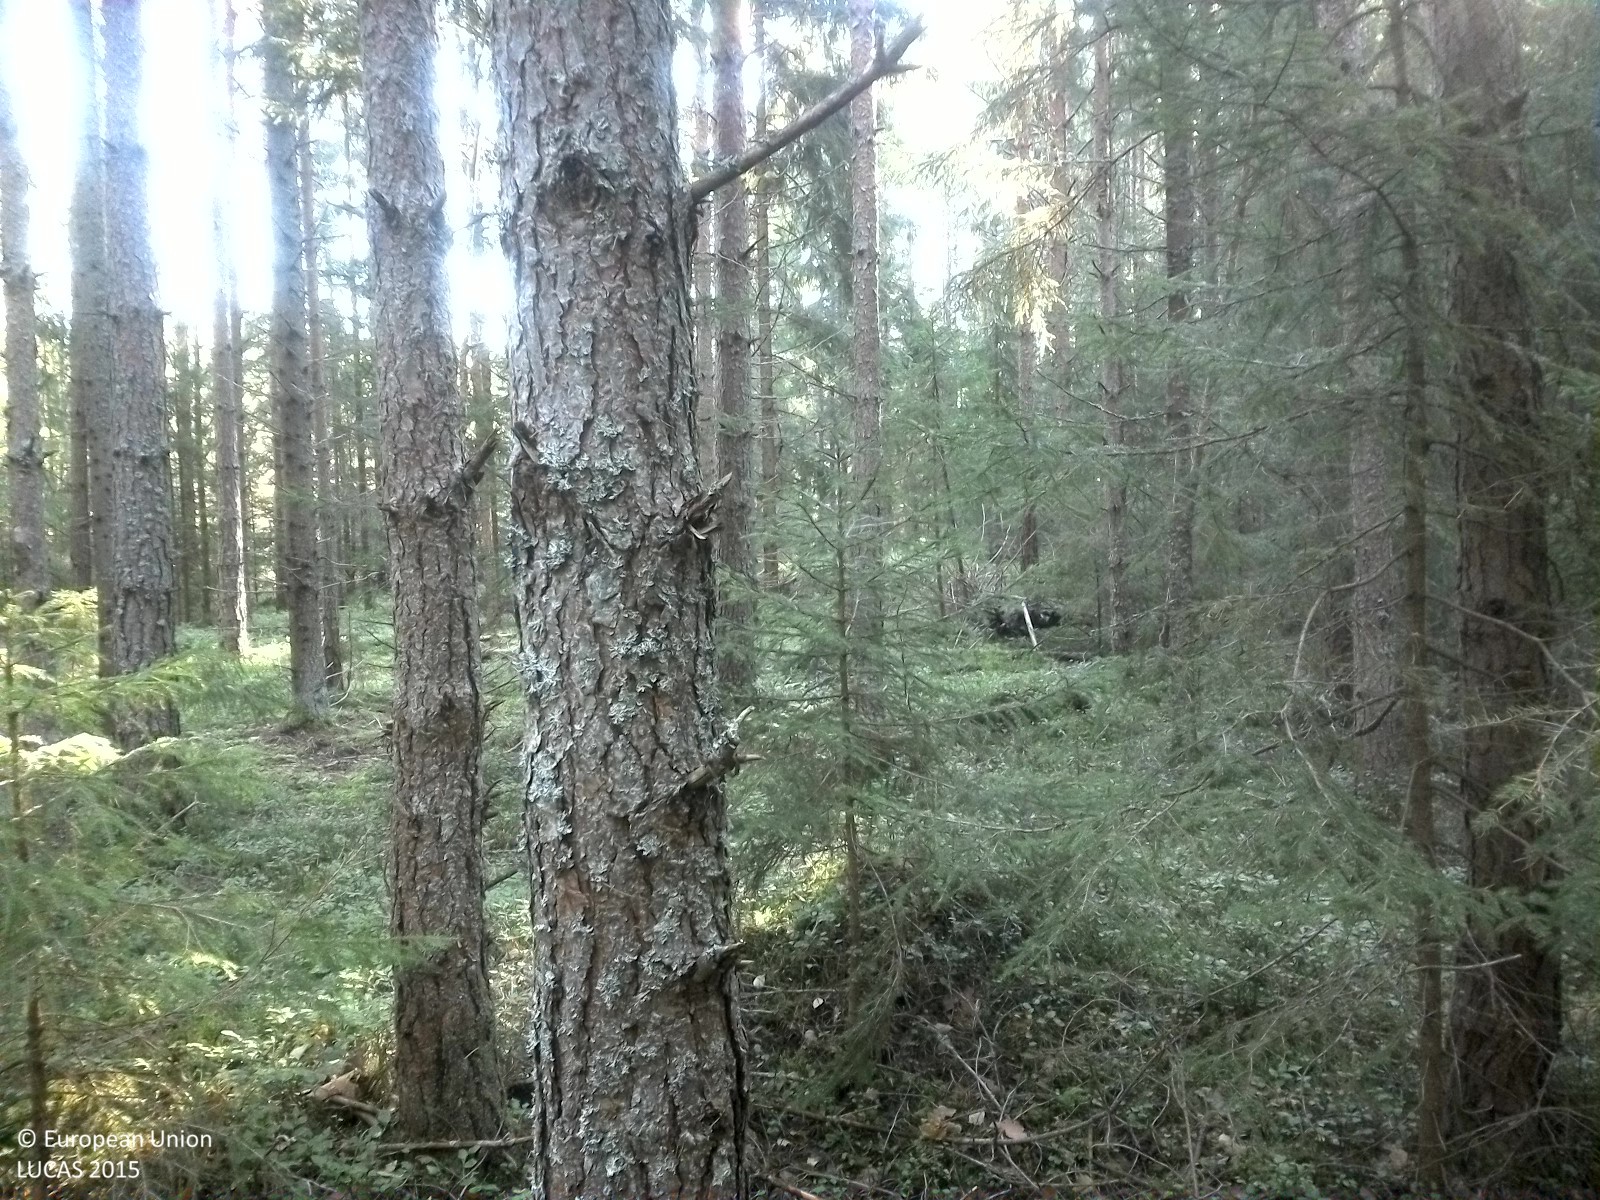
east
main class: Woodland
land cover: Other coniferous woodland
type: boreal forest
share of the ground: 25 - 50 %
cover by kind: coniferous forest trees 45 %, herbaceous plants 35 %, lichens and mosses 20 %
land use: Forestry
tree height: > 5 m
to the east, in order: Other coniferous woodland; Spruce dominated mixed woodland; Other coniferous woodland; Tracks; Other coniferous woodland; Tracks; Other coniferous woodland
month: September
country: SE
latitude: 59.1030
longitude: 15.8417
